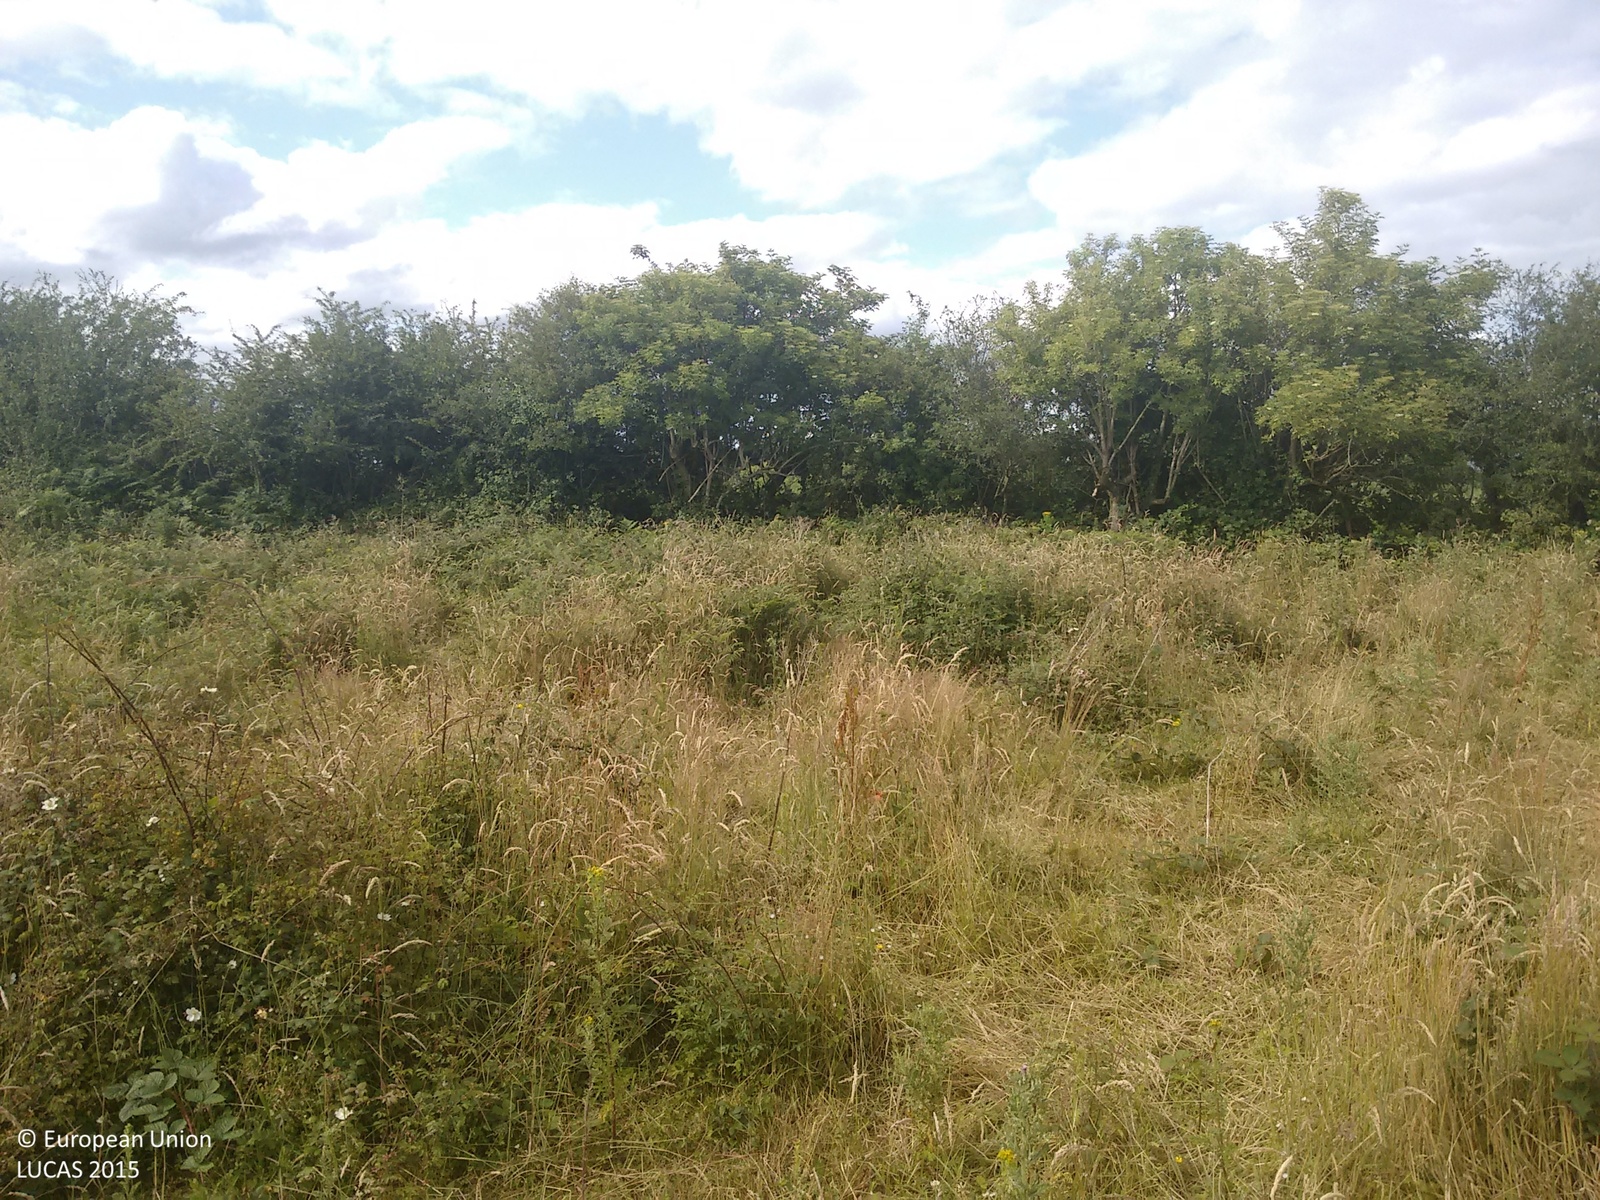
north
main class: Grassland
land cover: Spontaneously vegetated surfaces
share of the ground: > 75 %
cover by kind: herbaceous plants 95 %, shrubs 5 %
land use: Fallow land
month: July
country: IE
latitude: 53.5935
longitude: -7.8312
